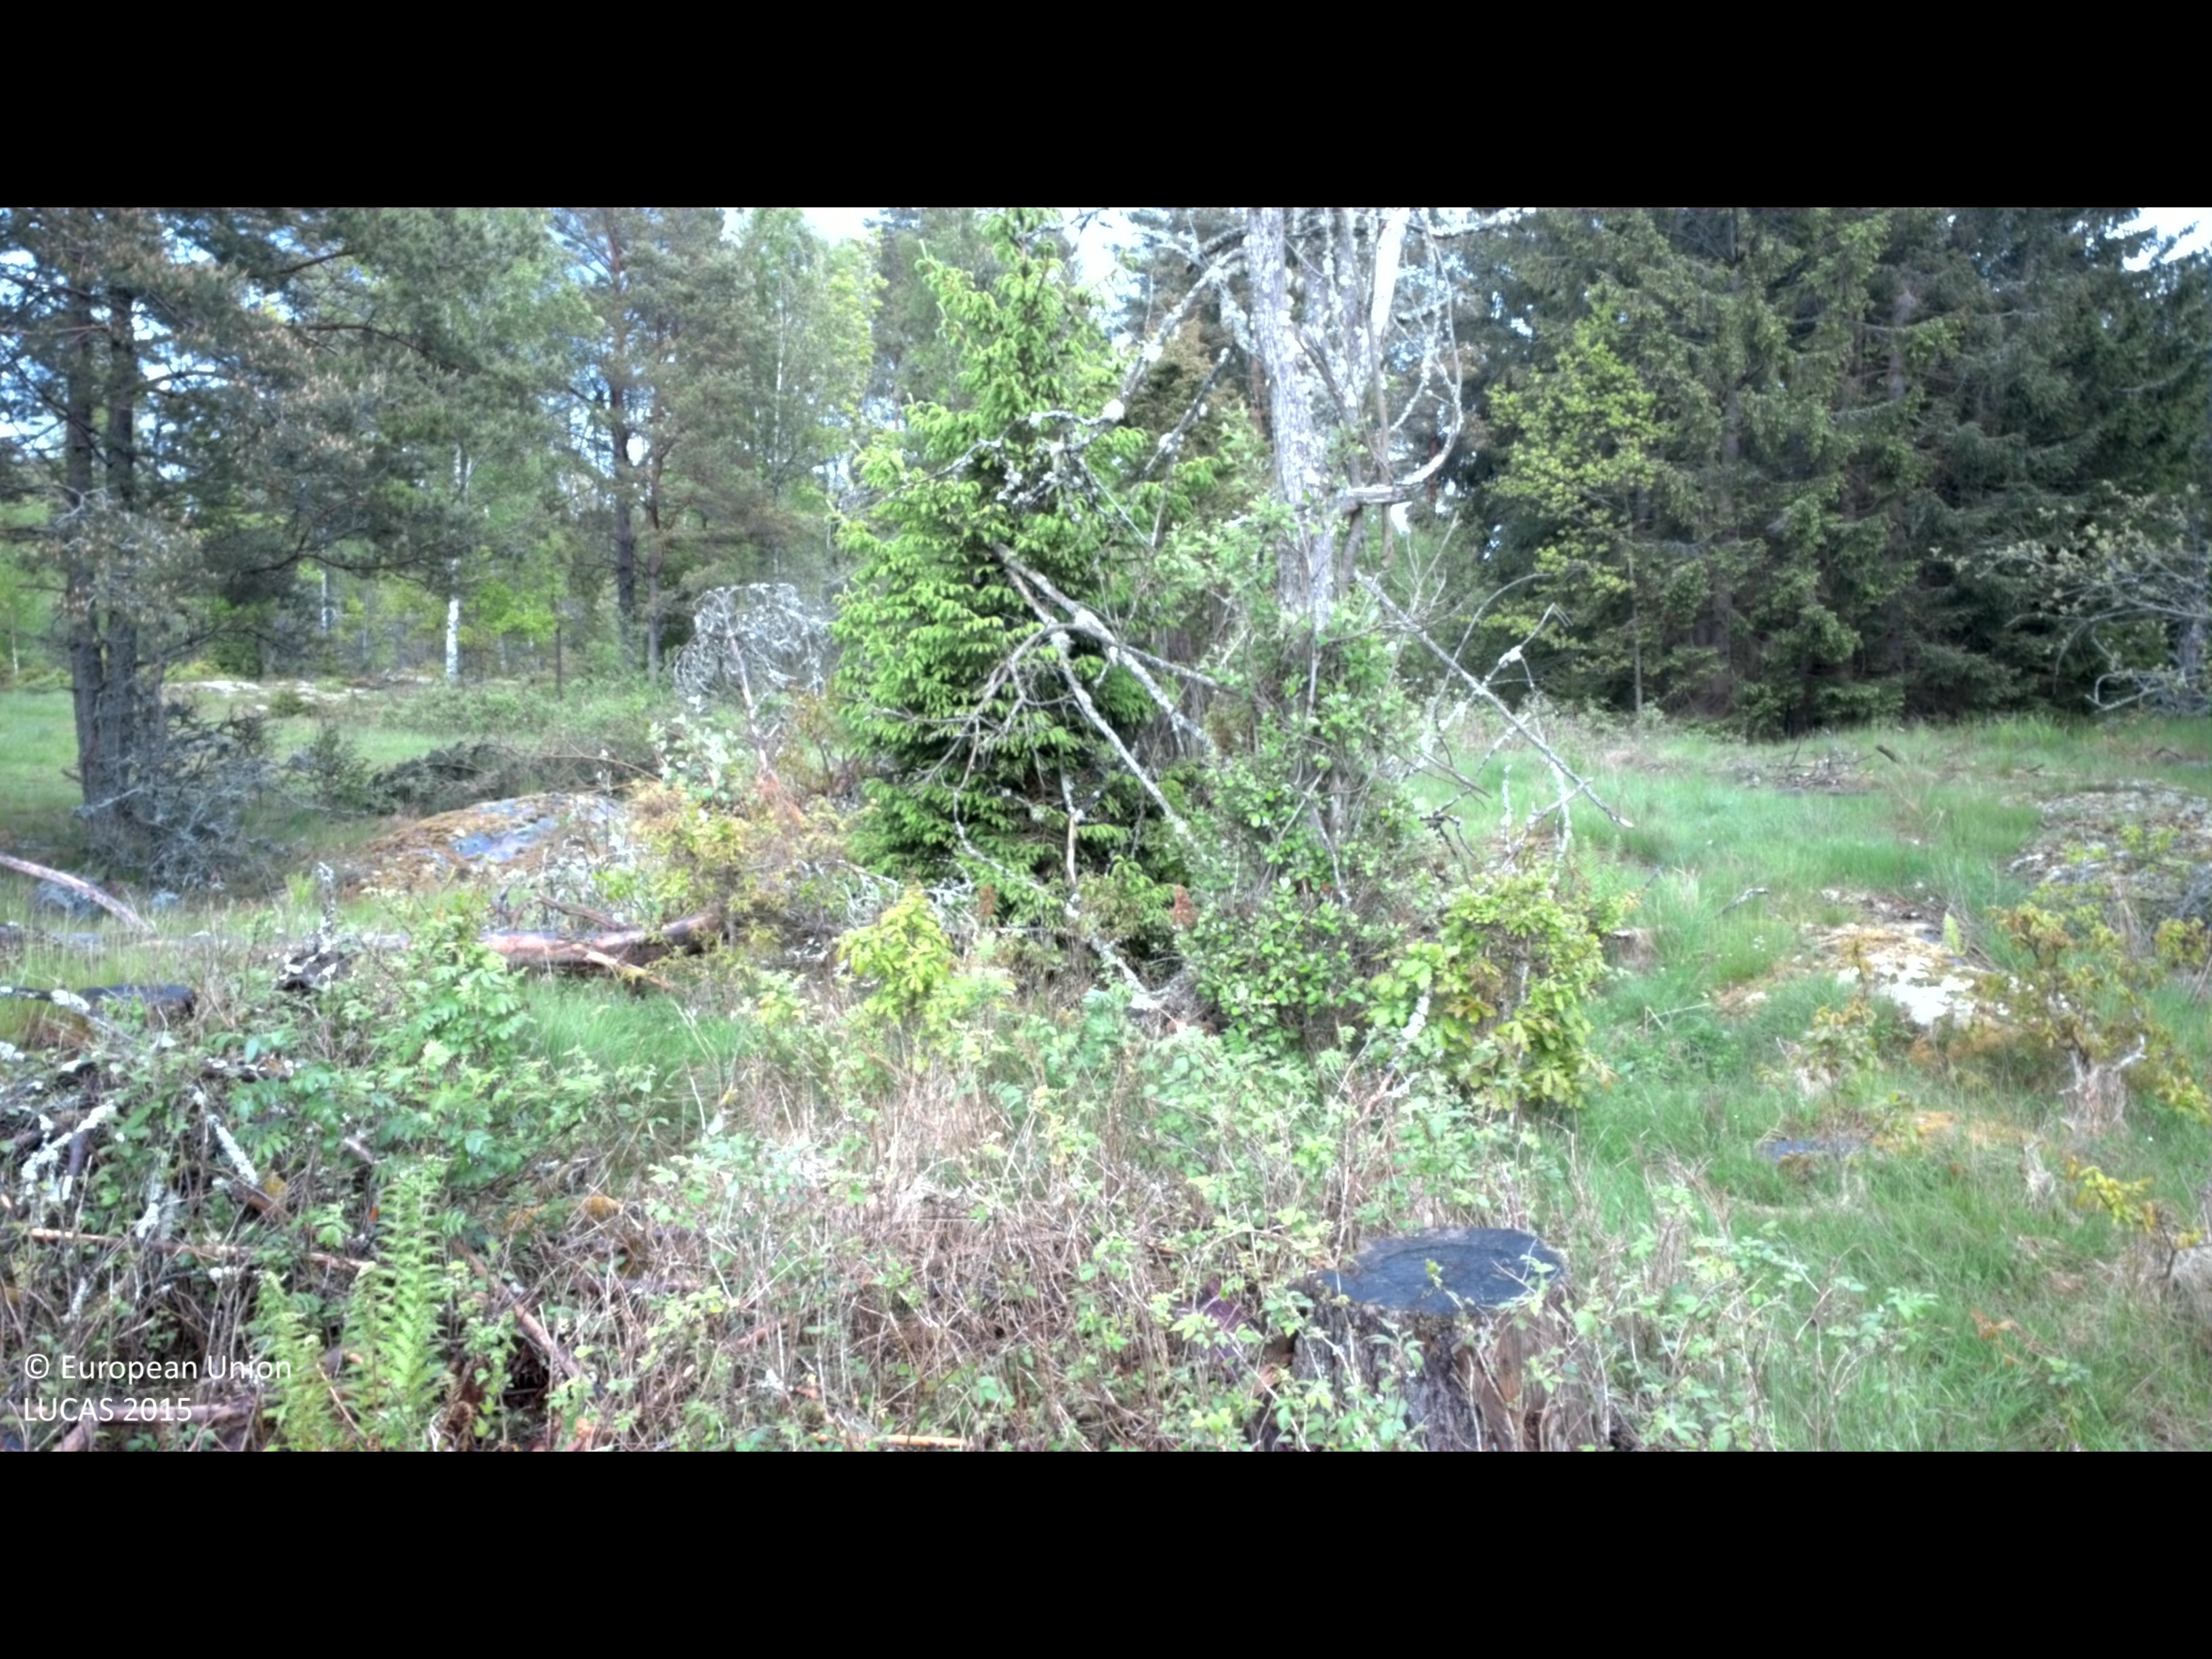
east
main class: Woodland
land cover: Broadleaved woodland
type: hemiboreal forest and nemoral coniferous forest and mixed broadleaved-coniferous forest
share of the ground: 25 - 50 %
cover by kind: broadleaved forest trees 40 %, shrubs 25 %, herbaceous plants 20 %, coniferous forest trees 10 %, lichens and mosses 5 %
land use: Forestry
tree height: > 5 m
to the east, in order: Broadleaved woodland; Tracks; Pine dominated mixed woodland; Spruce dominated mixed woodland; Pine dominated mixed woodland; Spruce dominated mixed woodland
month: May
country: SE
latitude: 57.4462
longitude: 16.5479
